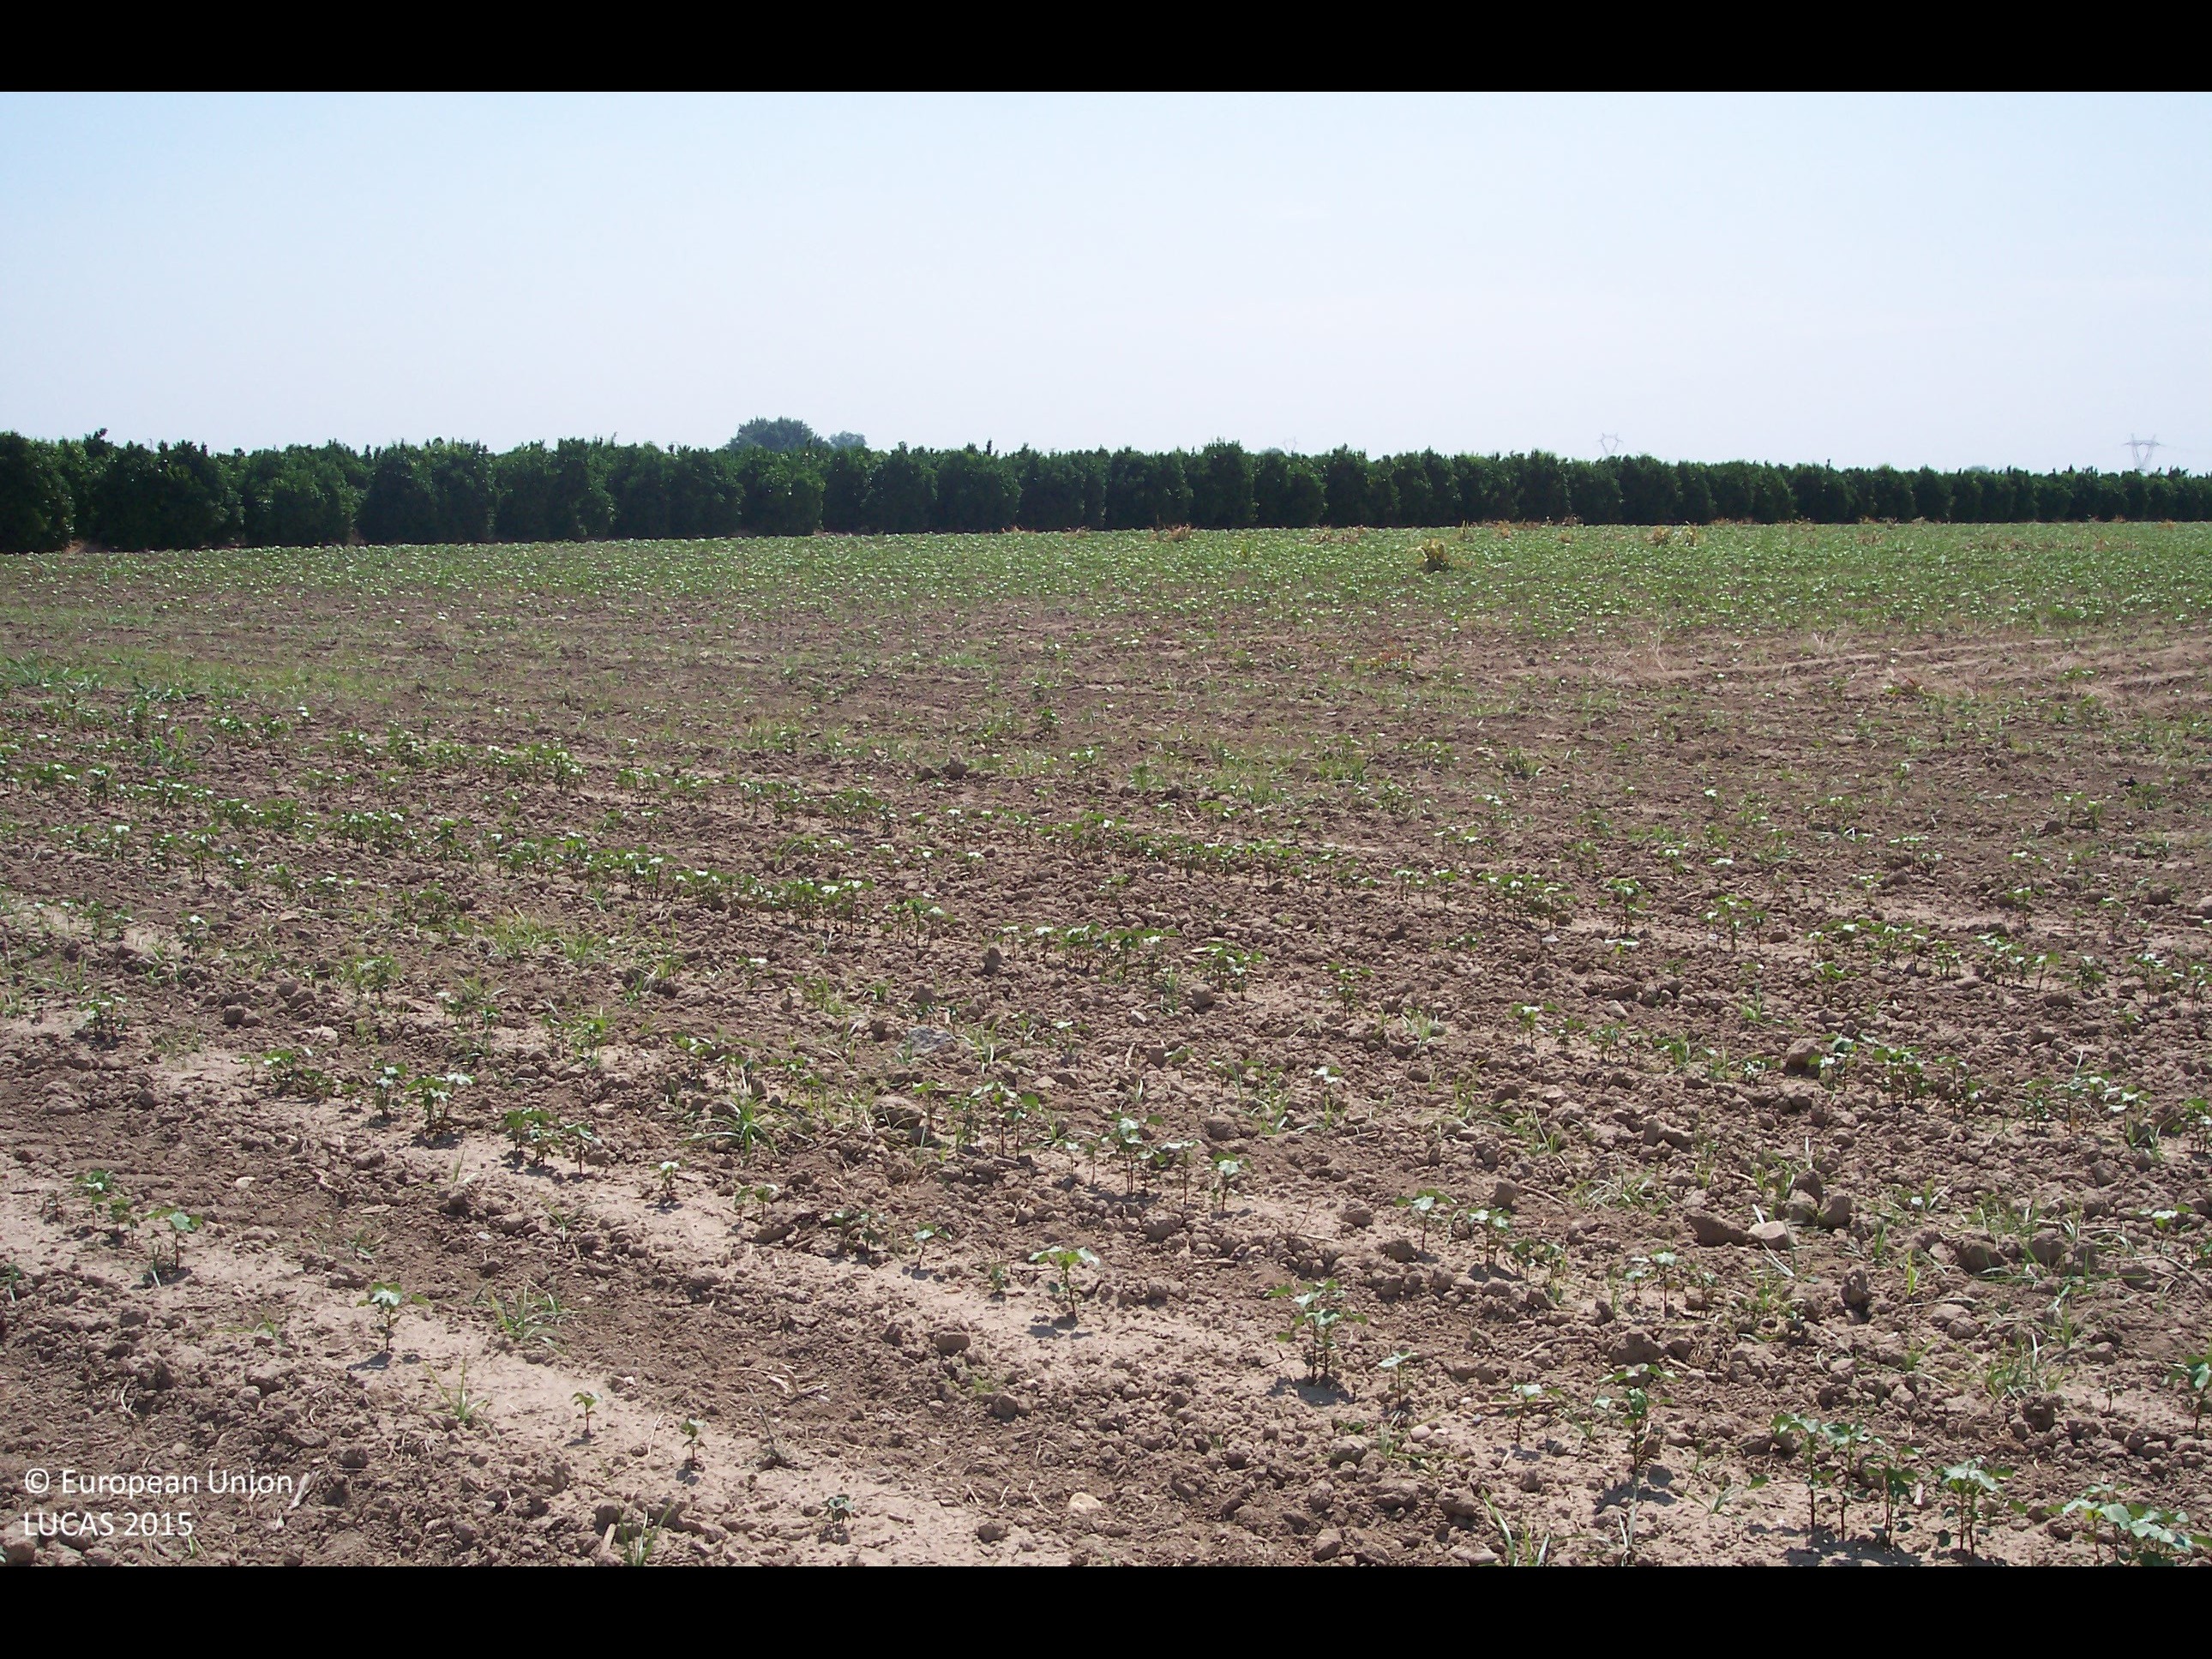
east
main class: Cropland
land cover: Cotton
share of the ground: < 10 %
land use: Agriculture (excluding fallow land and kitchen gardens)
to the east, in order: Cotton; Oranges
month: May
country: ES
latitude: 37.5389
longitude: -5.9264
